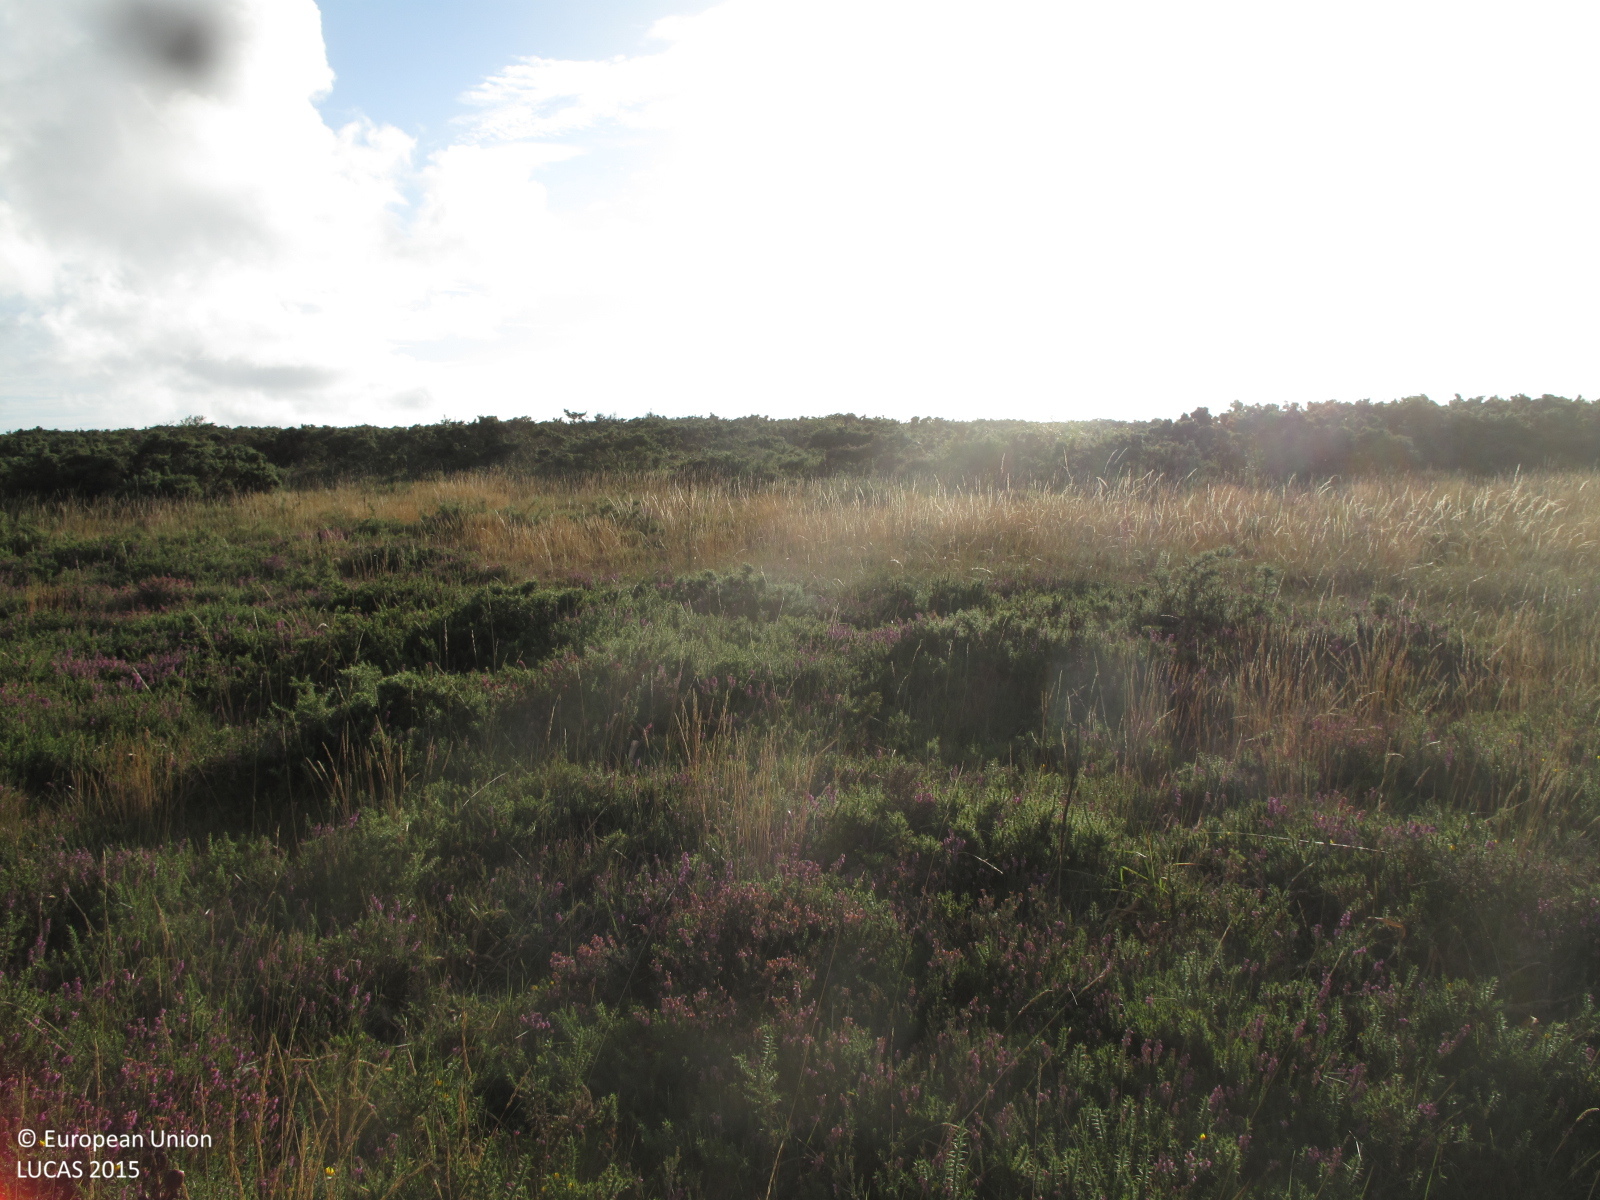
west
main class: Shrubland
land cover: Shrubland without tree cover
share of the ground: > 75 %
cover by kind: shrubs 80 %, herbaceous plants 20 %
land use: Abandoned areas
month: July
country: ES
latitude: 42.9822
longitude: -9.0952
